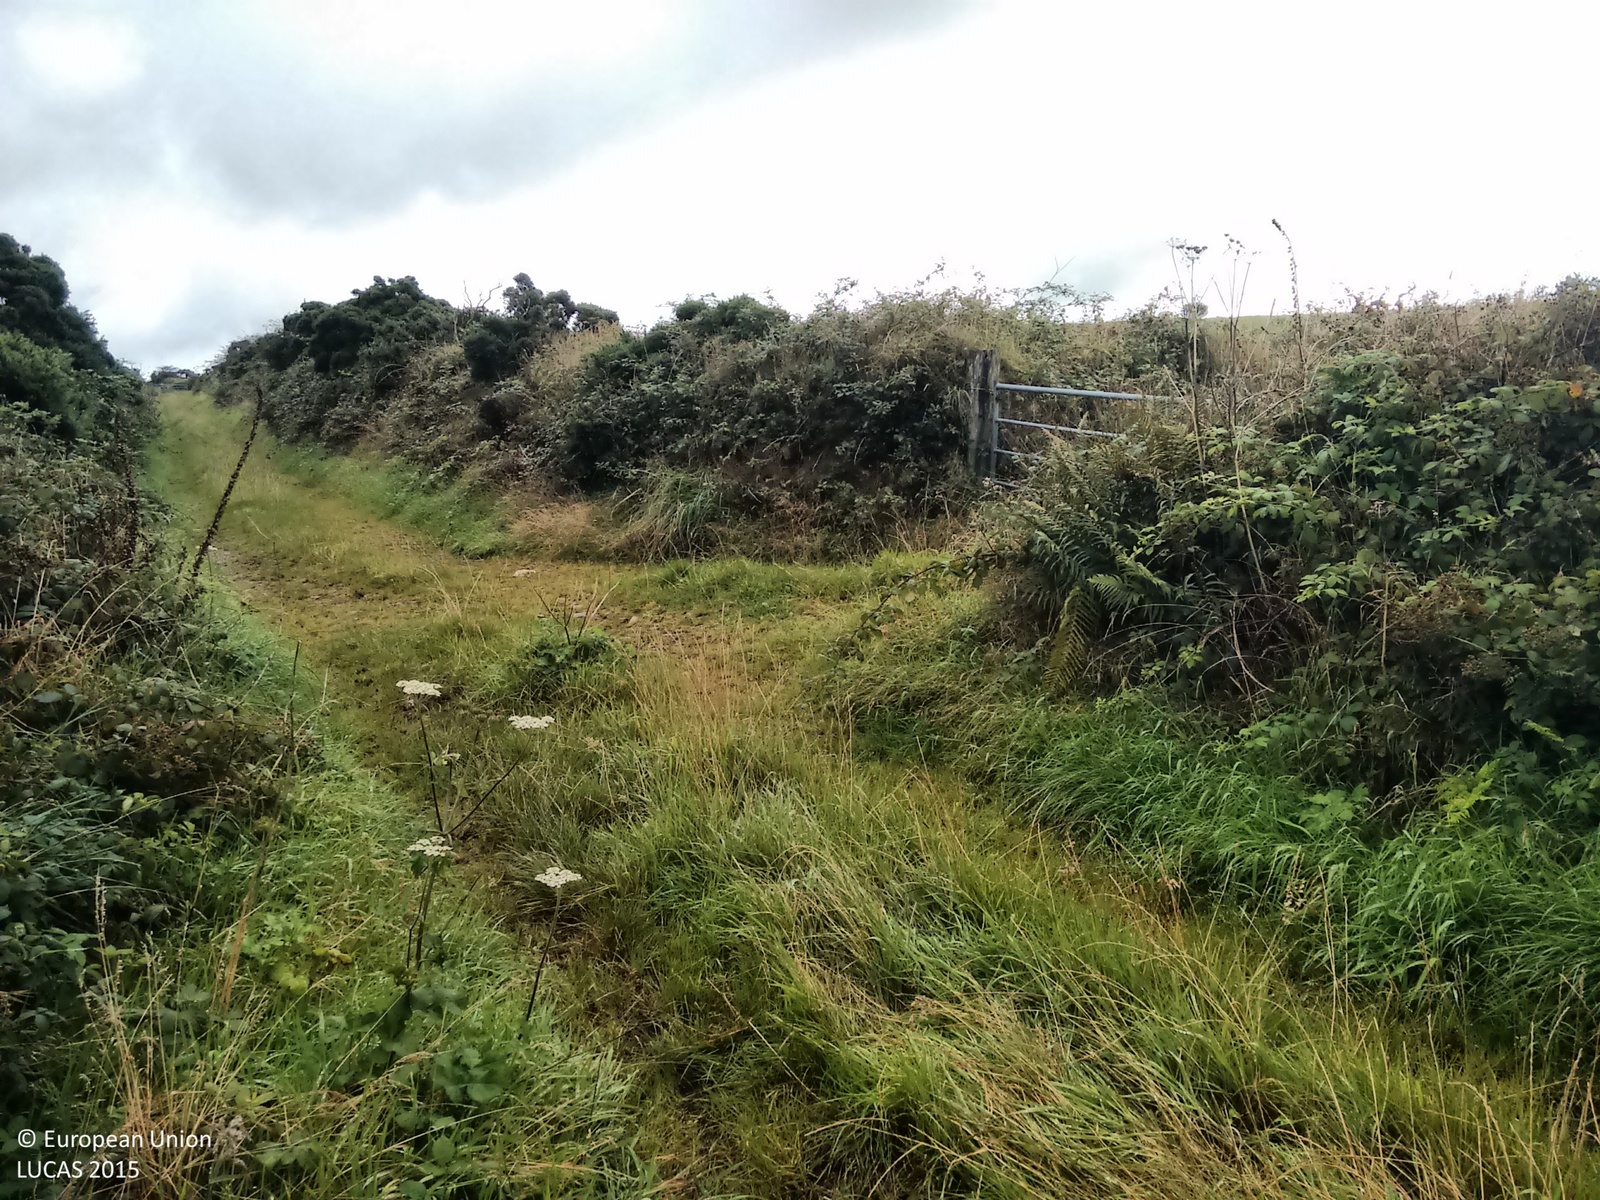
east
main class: Grassland
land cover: Grassland without tree/shrub cover
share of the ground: > 75 %
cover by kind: herbaceous plants 100 %
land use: Agriculture (excluding fallow land and kitchen gardens)
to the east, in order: Grassland without tree/shrub cover; Fences; Managed hedges; Artificial constructions; Tracks; Managed hedges; Artificial constructions; Grassland without tree/shrub cover; Managed hedges; Artificial constructions; Grassland without tree/shrub cover; Fences; Grassland without tree/shrub cover
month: September
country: GB
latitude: 50.1957
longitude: -5.2360
